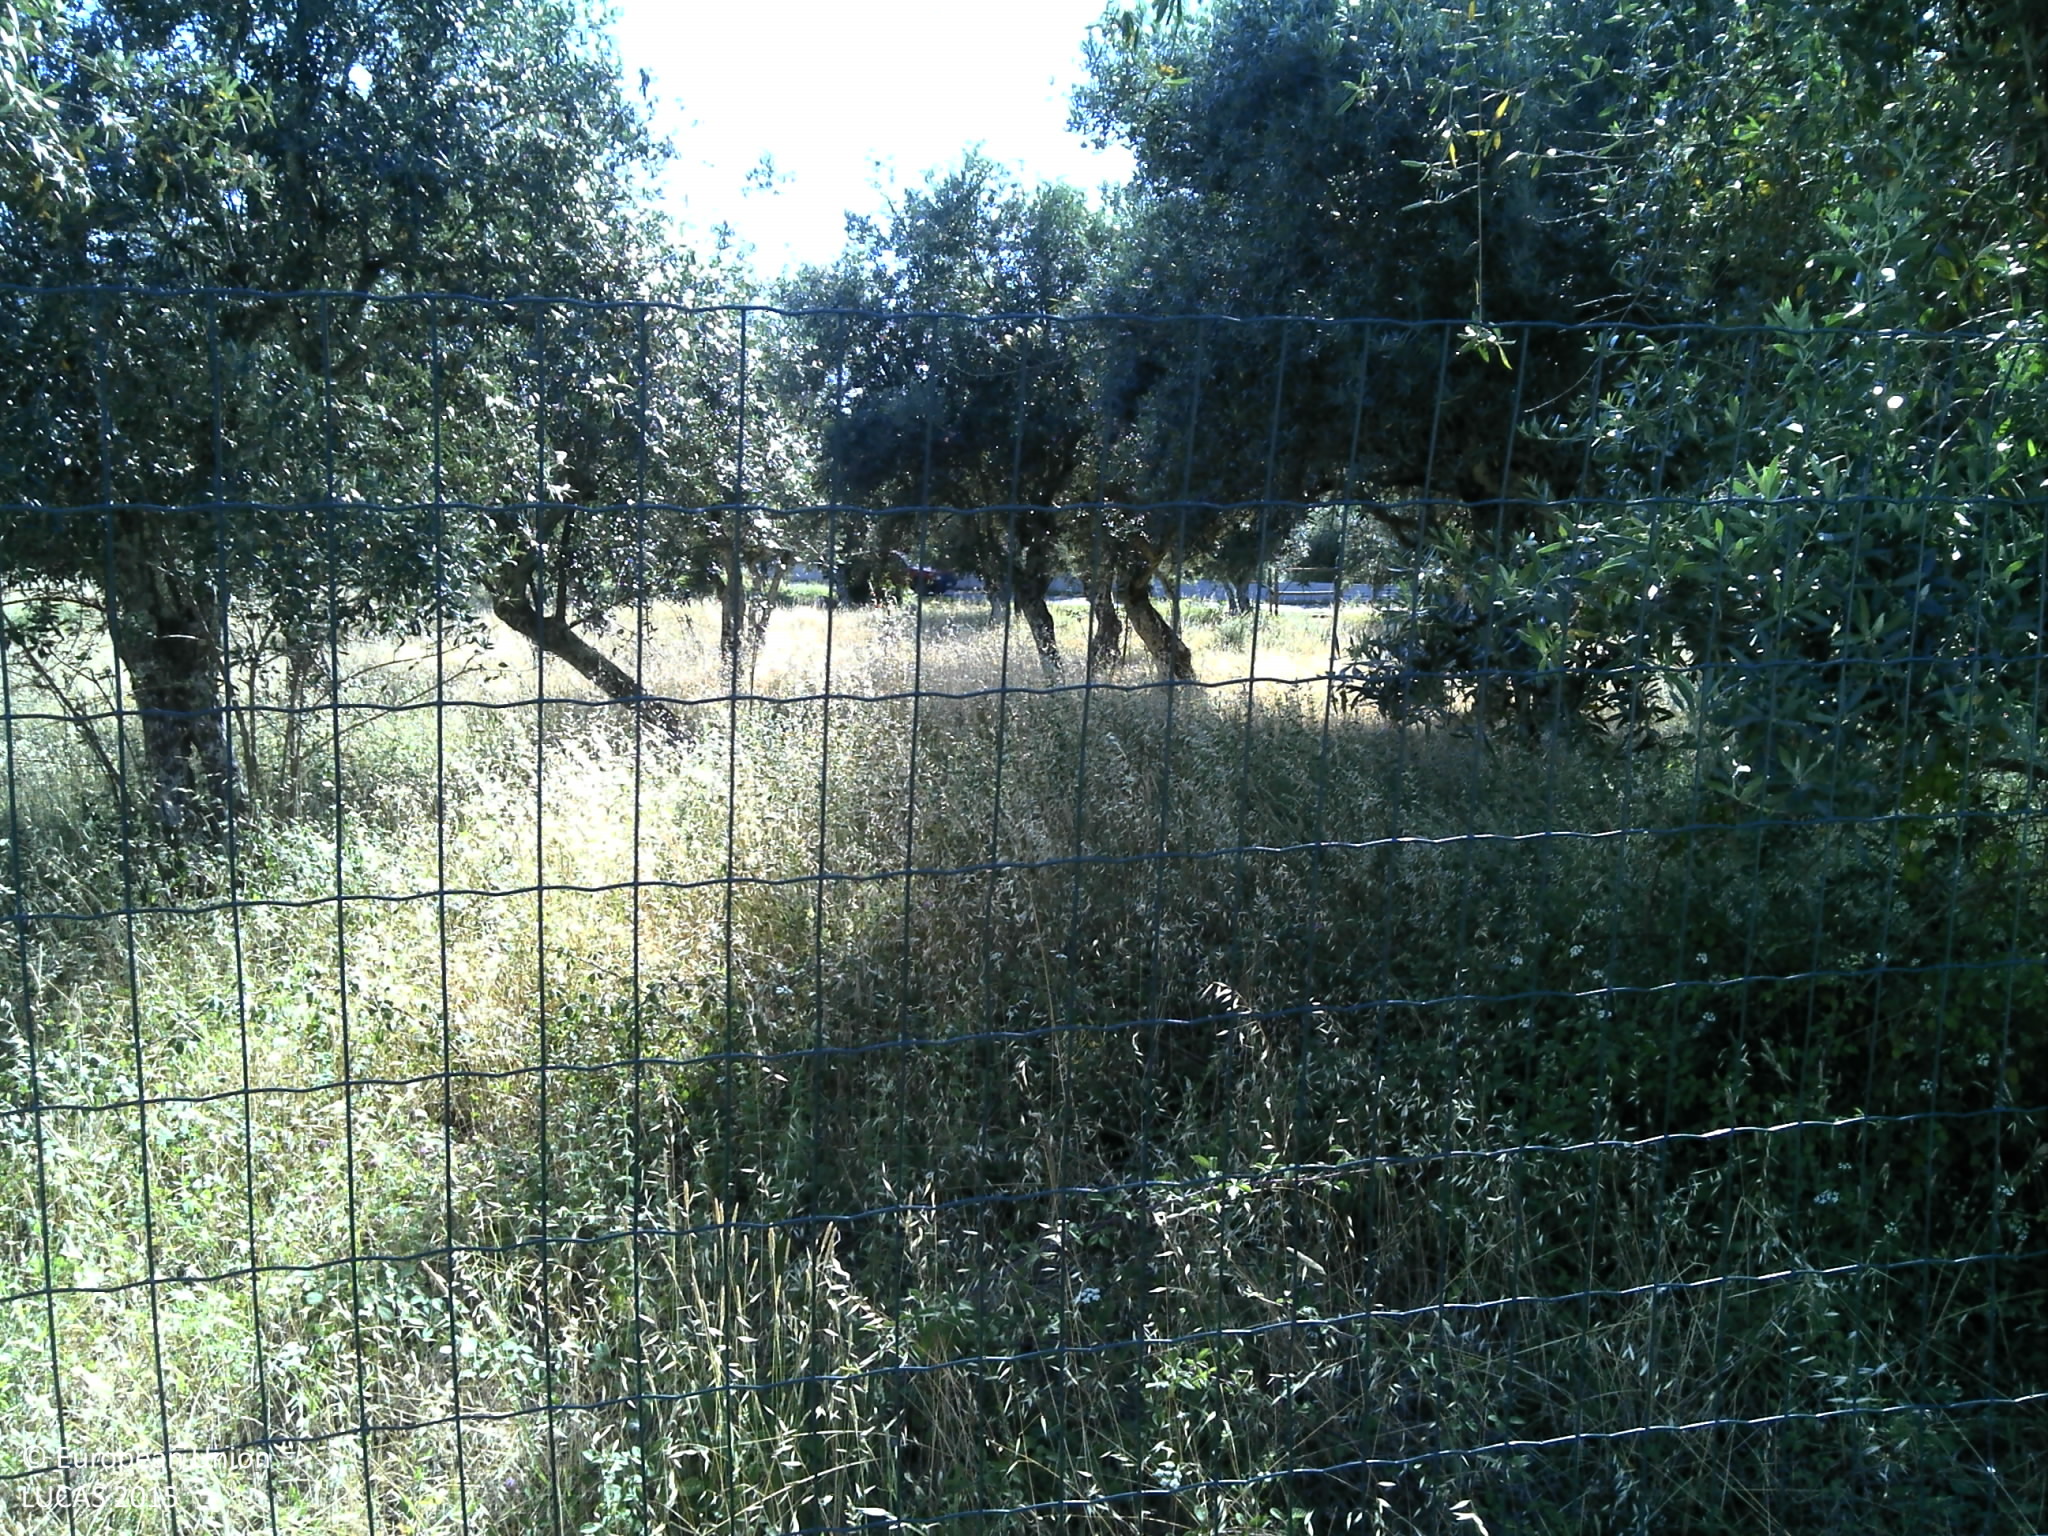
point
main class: Cropland
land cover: Olive groves
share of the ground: 25 - 50 %
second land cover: Grassland without tree/shrub cover
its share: 50 - 75 %
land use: Agriculture (excluding fallow land and kitchen gardens)
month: July
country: PT
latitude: 39.8171
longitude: -8.1410
